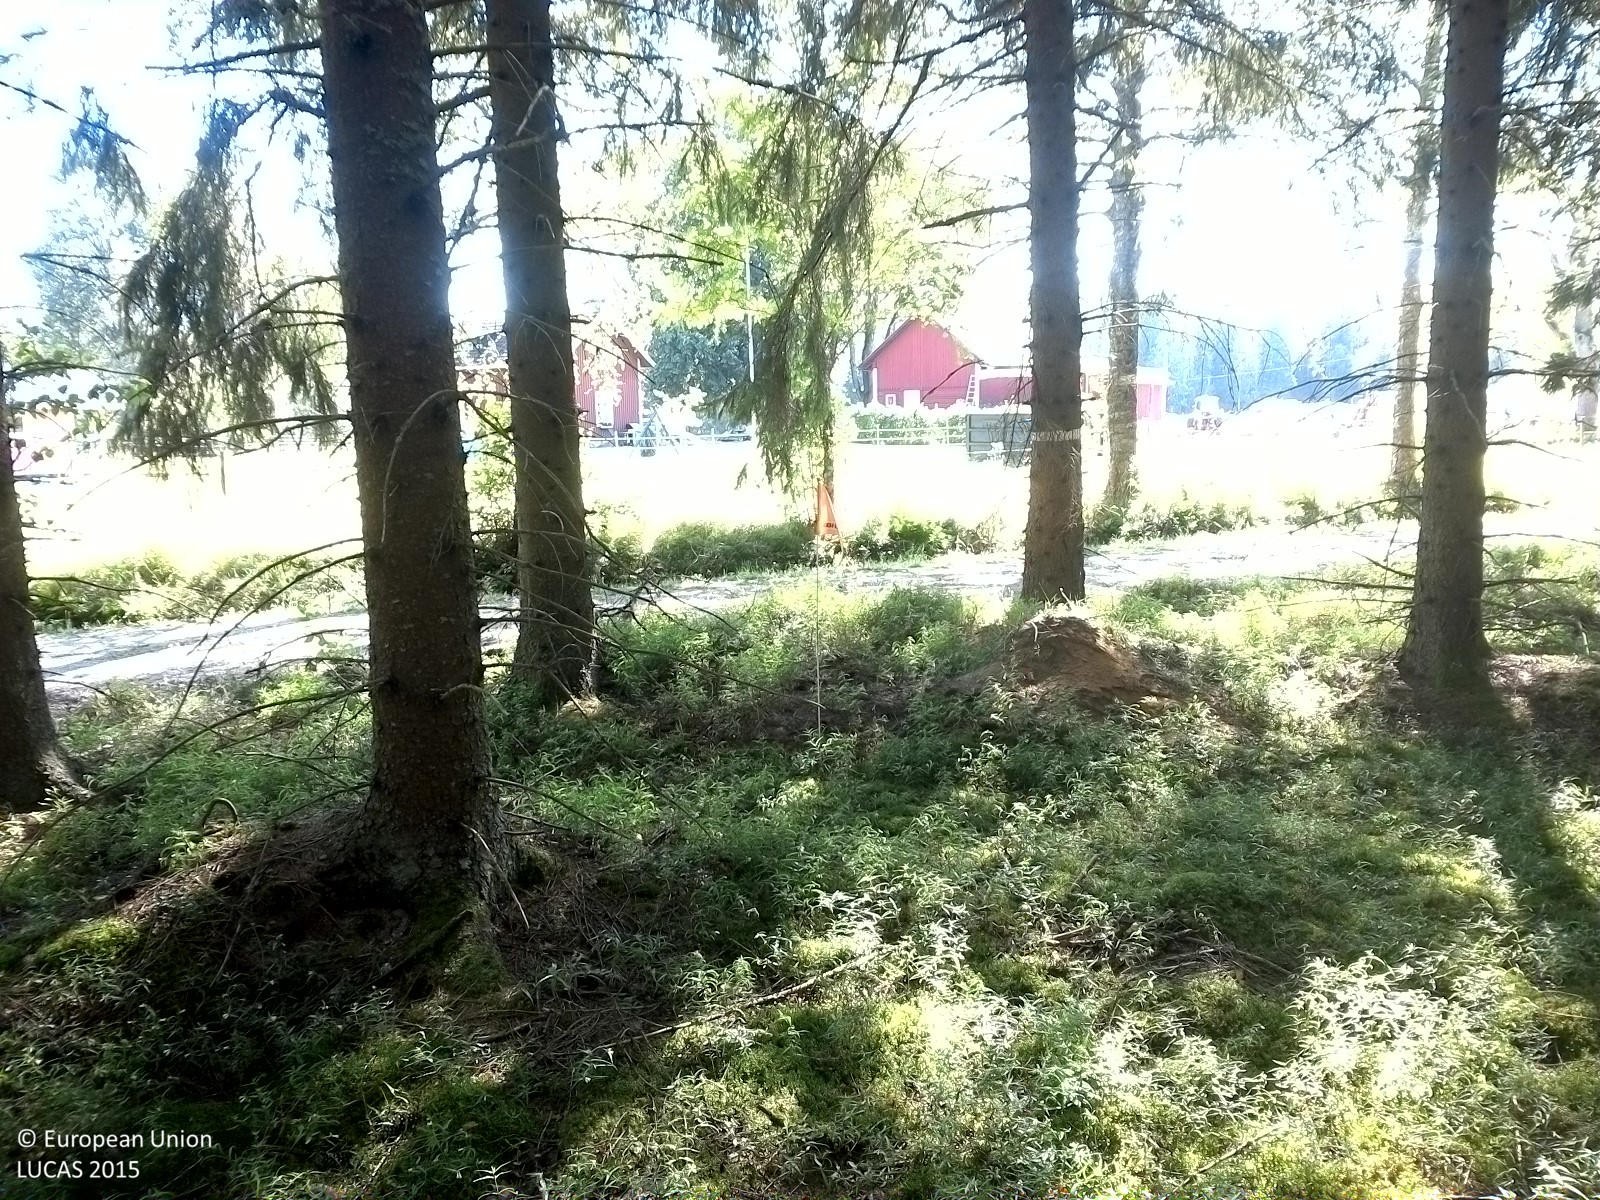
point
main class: Woodland
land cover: Spruce dominated coniferous woodland
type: boreal forest
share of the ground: 50 - 75 %
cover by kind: coniferous forest trees 55 %, lichens and mosses 25 %, herbaceous plants 20 %
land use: Forestry
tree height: > 5 m
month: August
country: SE
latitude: 59.4203
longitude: 15.1194
